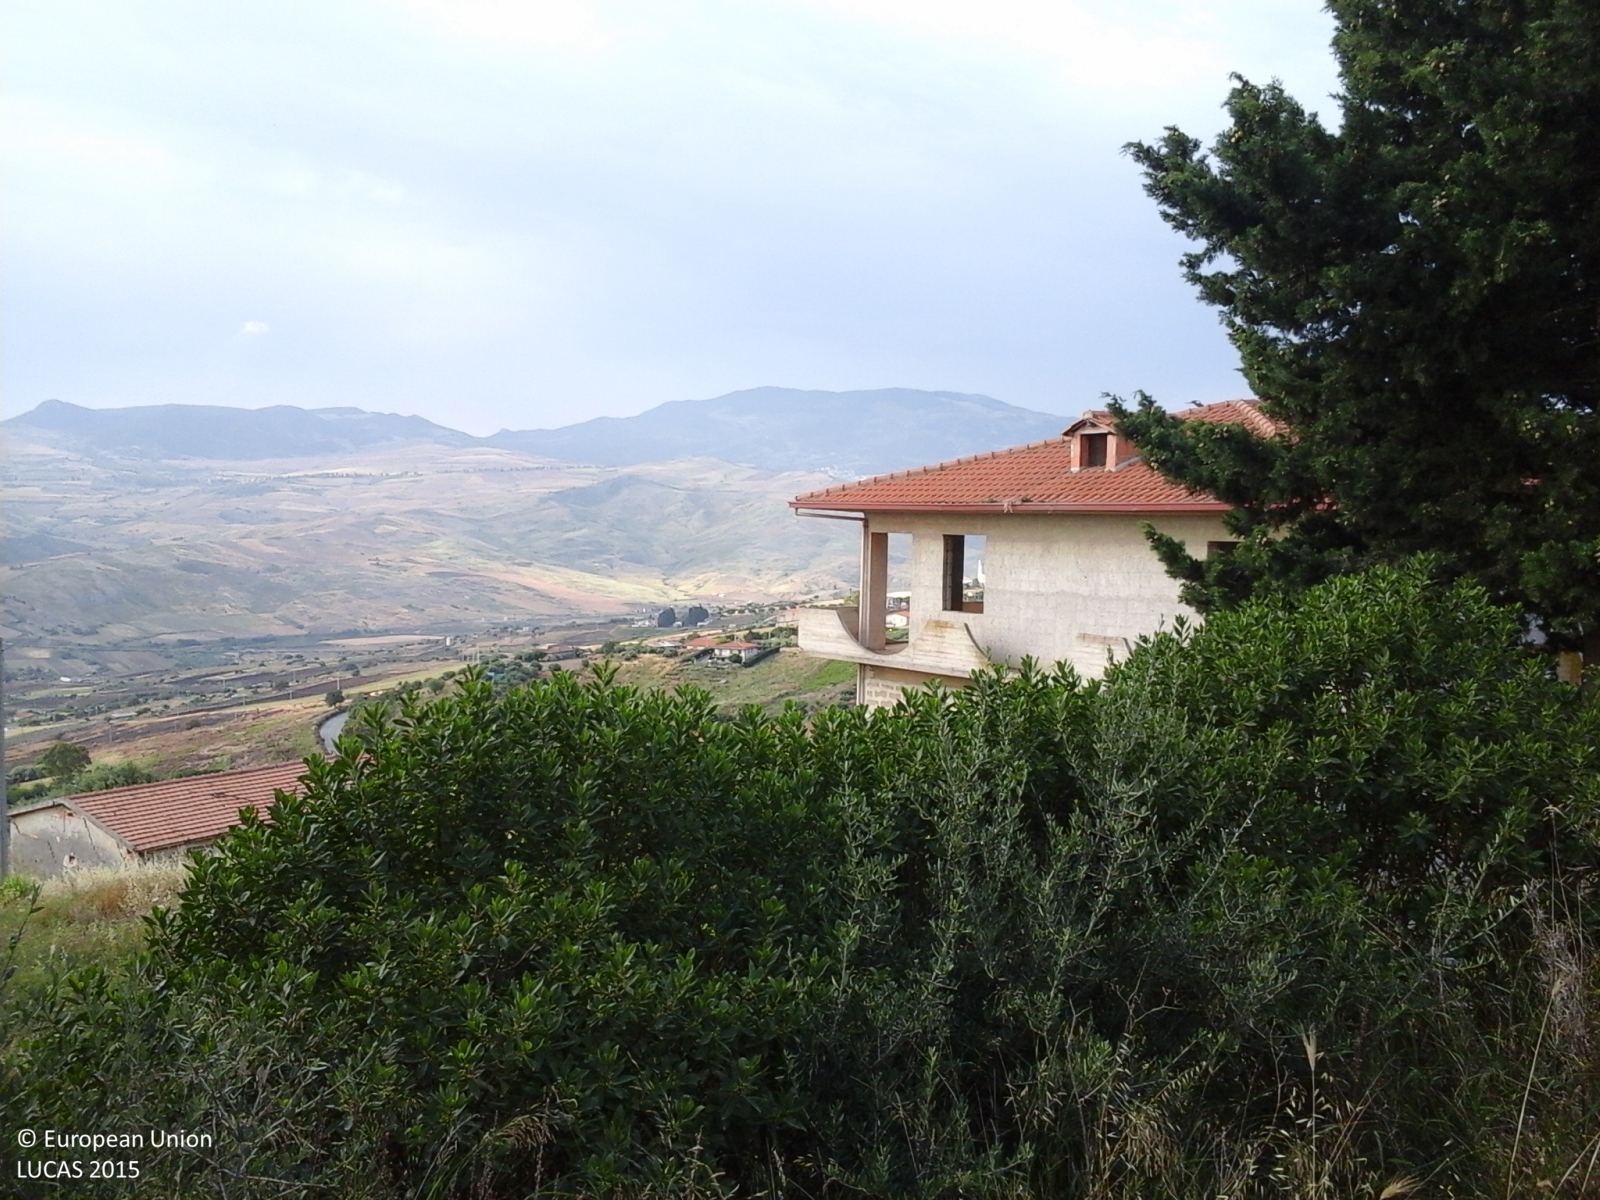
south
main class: Grassland
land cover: Grassland with sparse tree/shrub cover
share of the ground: > 75 %
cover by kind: herbaceous plants 85 %, shrubs 10 %, broadleaved forest trees 5 %
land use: Agriculture (excluding fallow land and kitchen gardens)
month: June
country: IT
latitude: 37.9275
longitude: 13.7618
